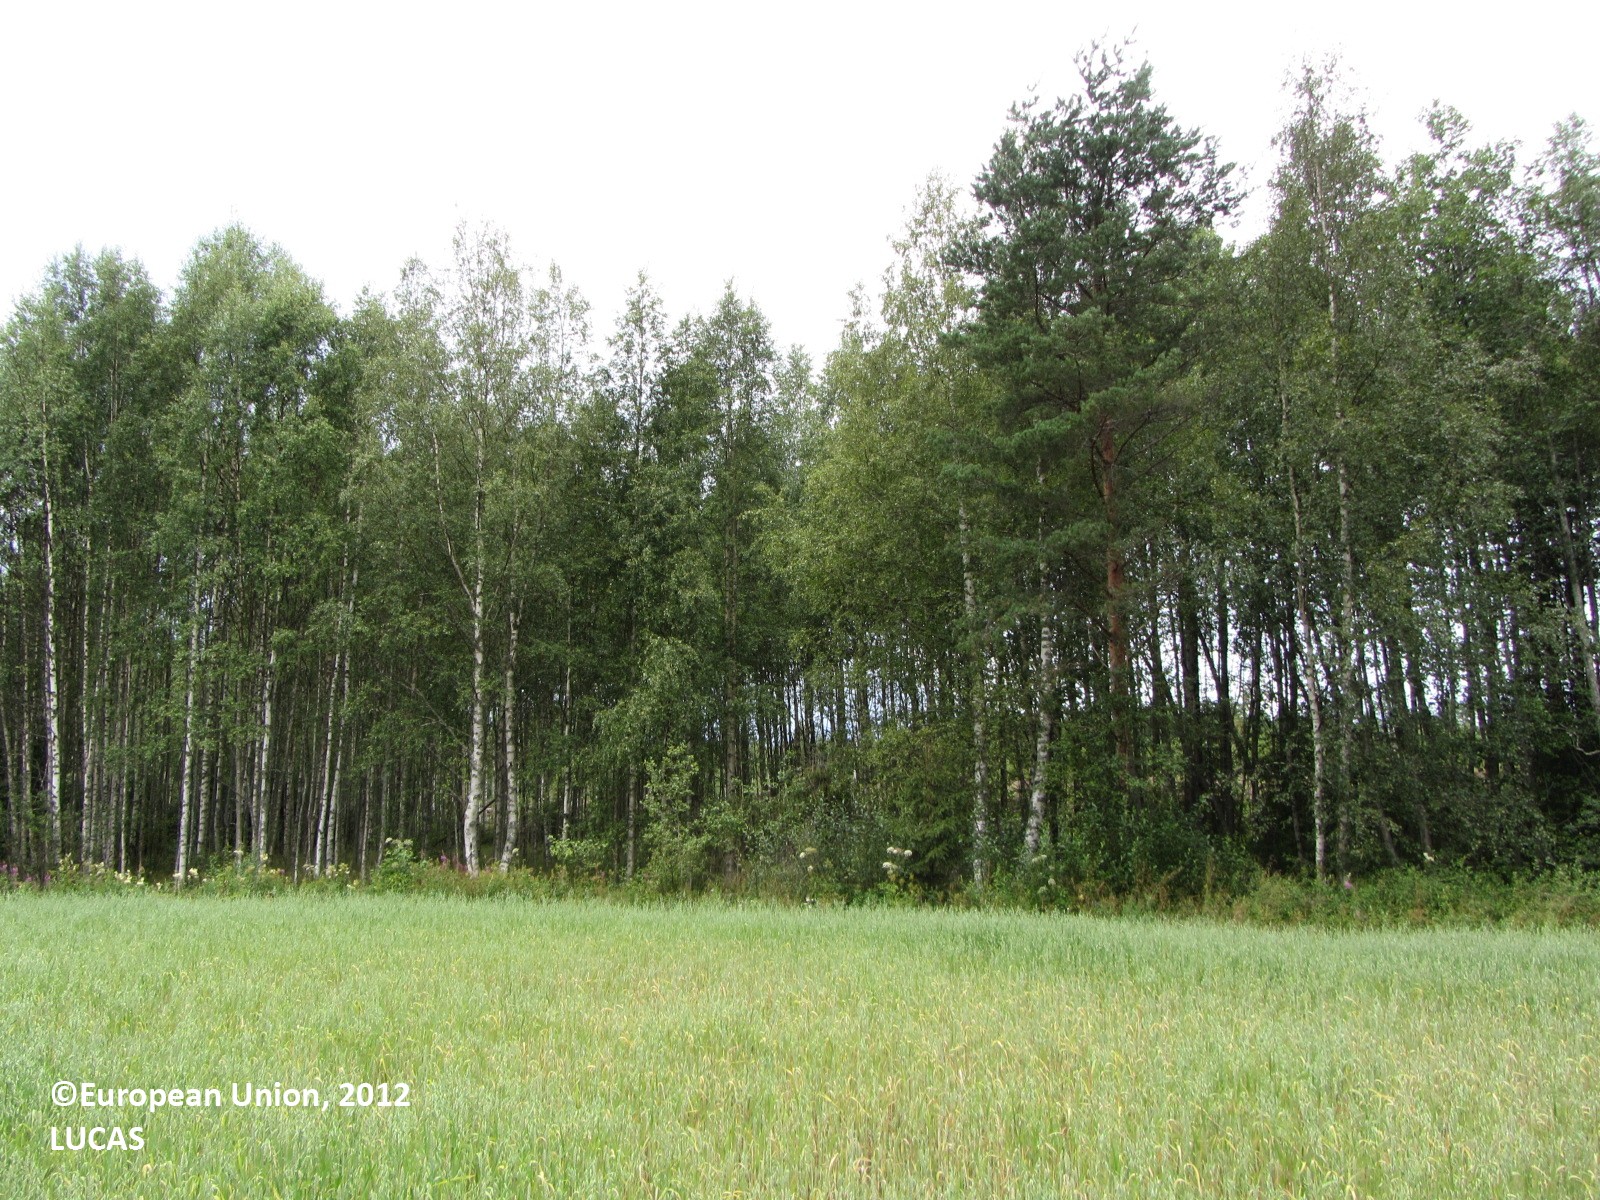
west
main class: Cropland
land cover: Mixed cereals for fodder
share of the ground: > 75 %
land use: Agriculture (excluding fallow land and kitchen gardens)
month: August
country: FI
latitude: 63.4452
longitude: 25.3153
